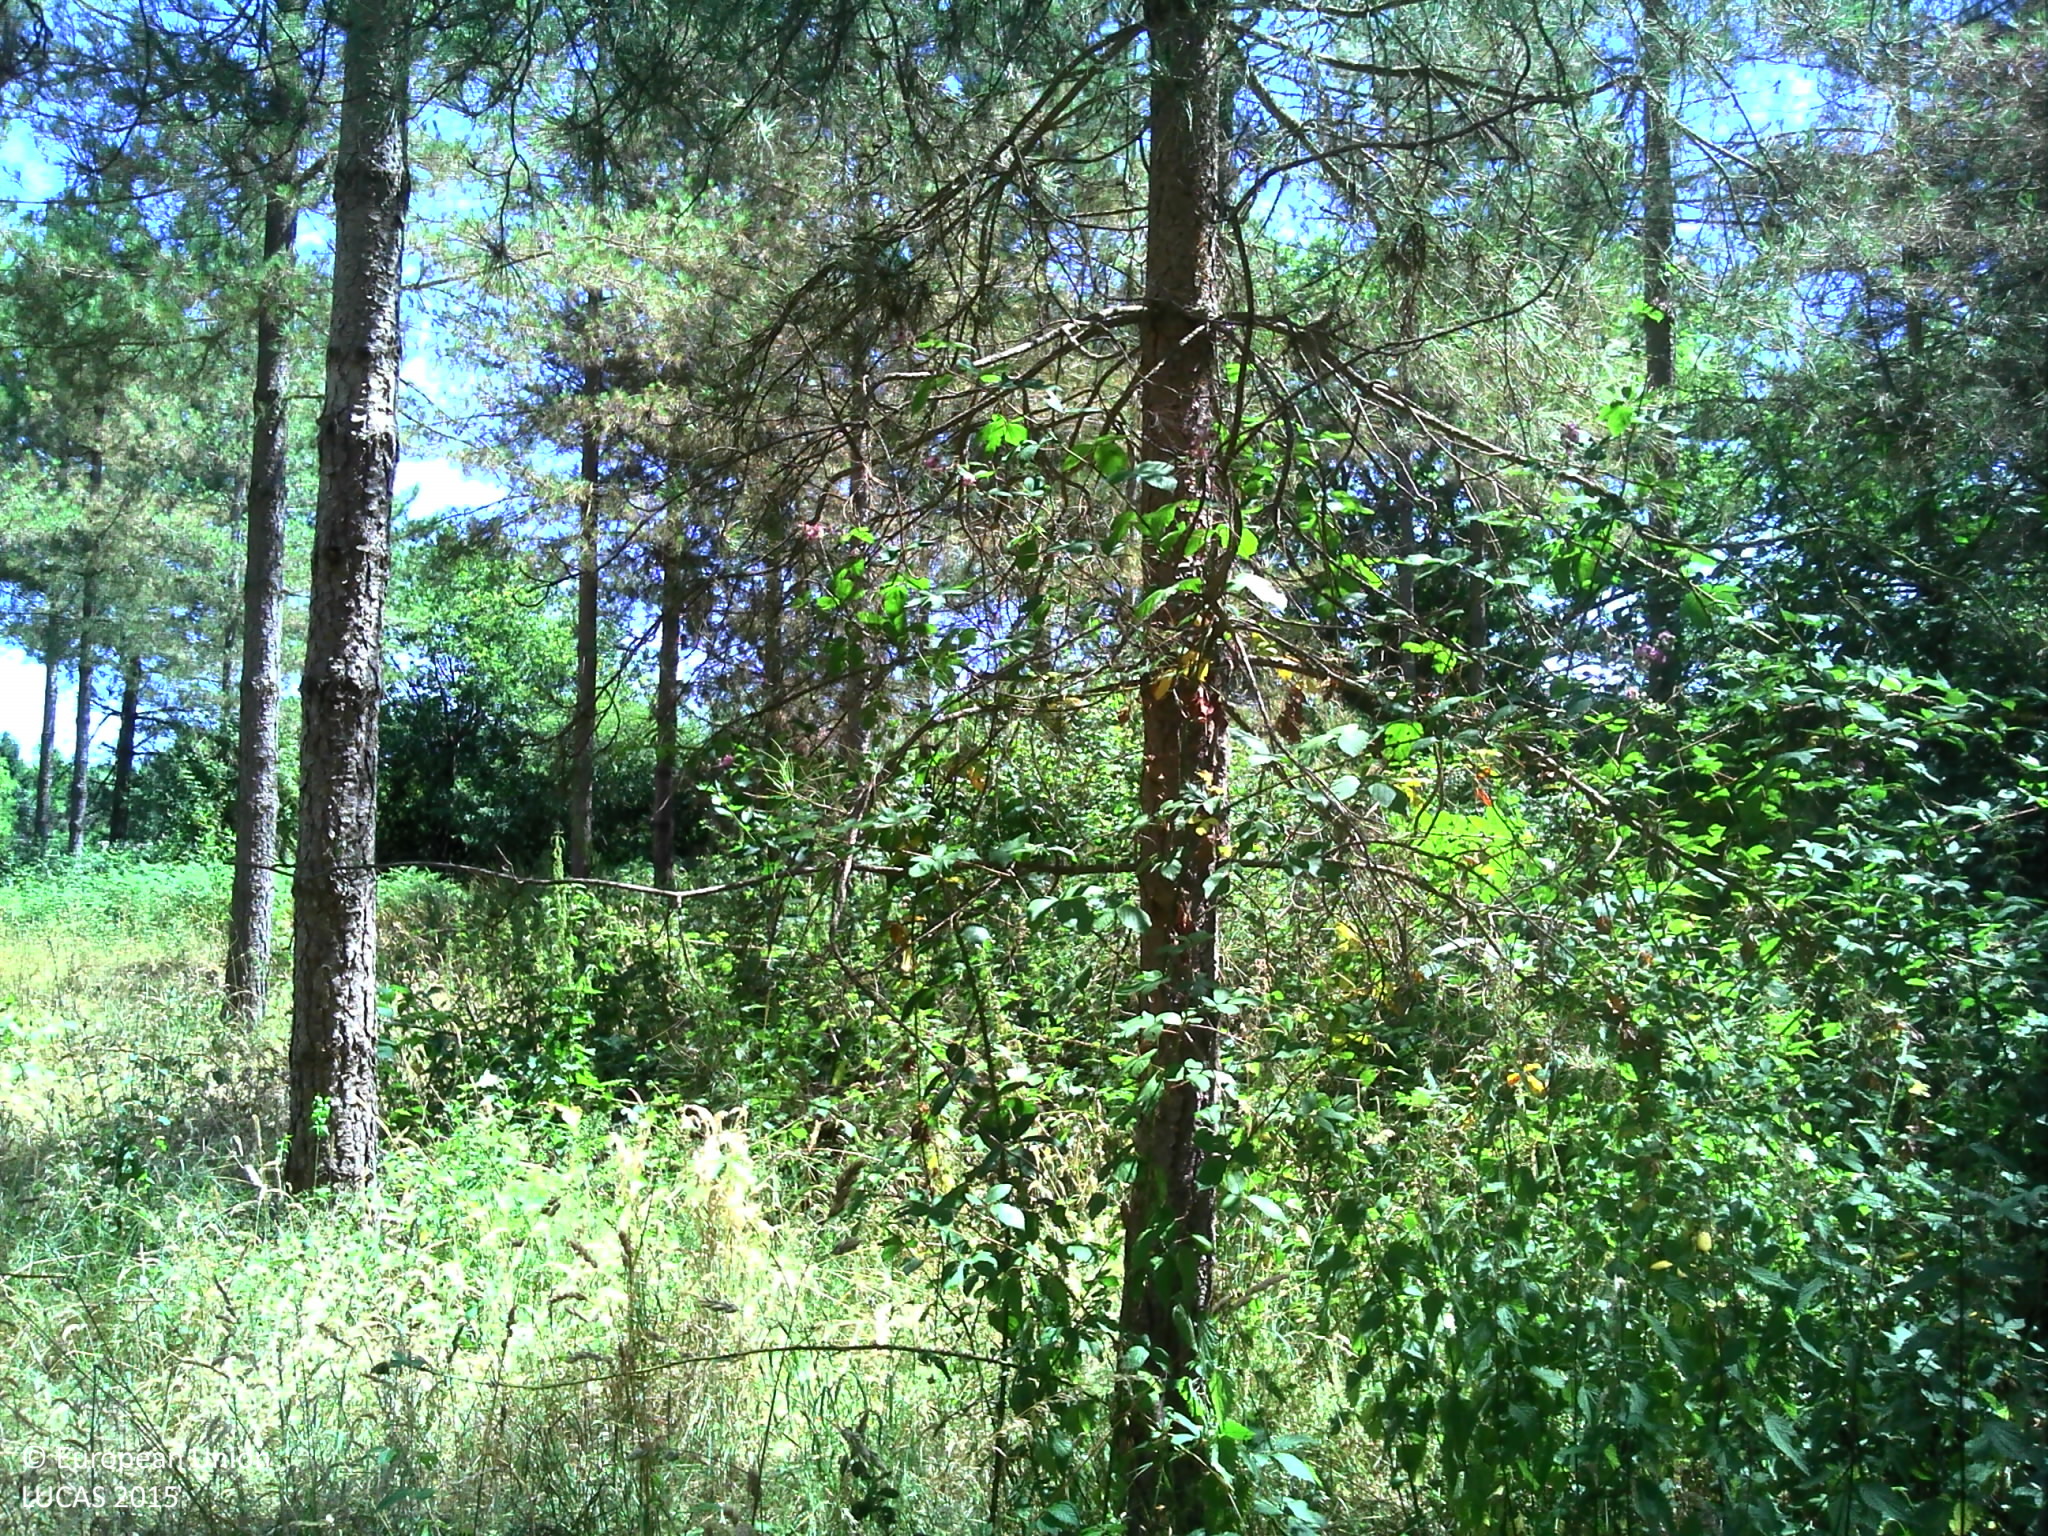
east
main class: Woodland
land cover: Spruce dominated coniferous woodland
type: exotic forest
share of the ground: > 75 %
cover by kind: coniferous forest trees 75 %, shrubs 15 %, herbaceous plants 10 %
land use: Forestry
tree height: > 5 m
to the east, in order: Spruce dominated coniferous woodland; Grassland without tree/shrub cover; Abandoned hedges; Grassland without tree/shrub cover; Artificial constructions in urban areas; Ditches and canals; Fences; Managed hedges; Grassland with sparse tree/shrub cover; Abandoned hedges; Grassland without tree/shrub cover; Abandoned hedges; Tracks; Spruce dominated coniferous woodland
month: June
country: FR
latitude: 47.9953
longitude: 0.3126
